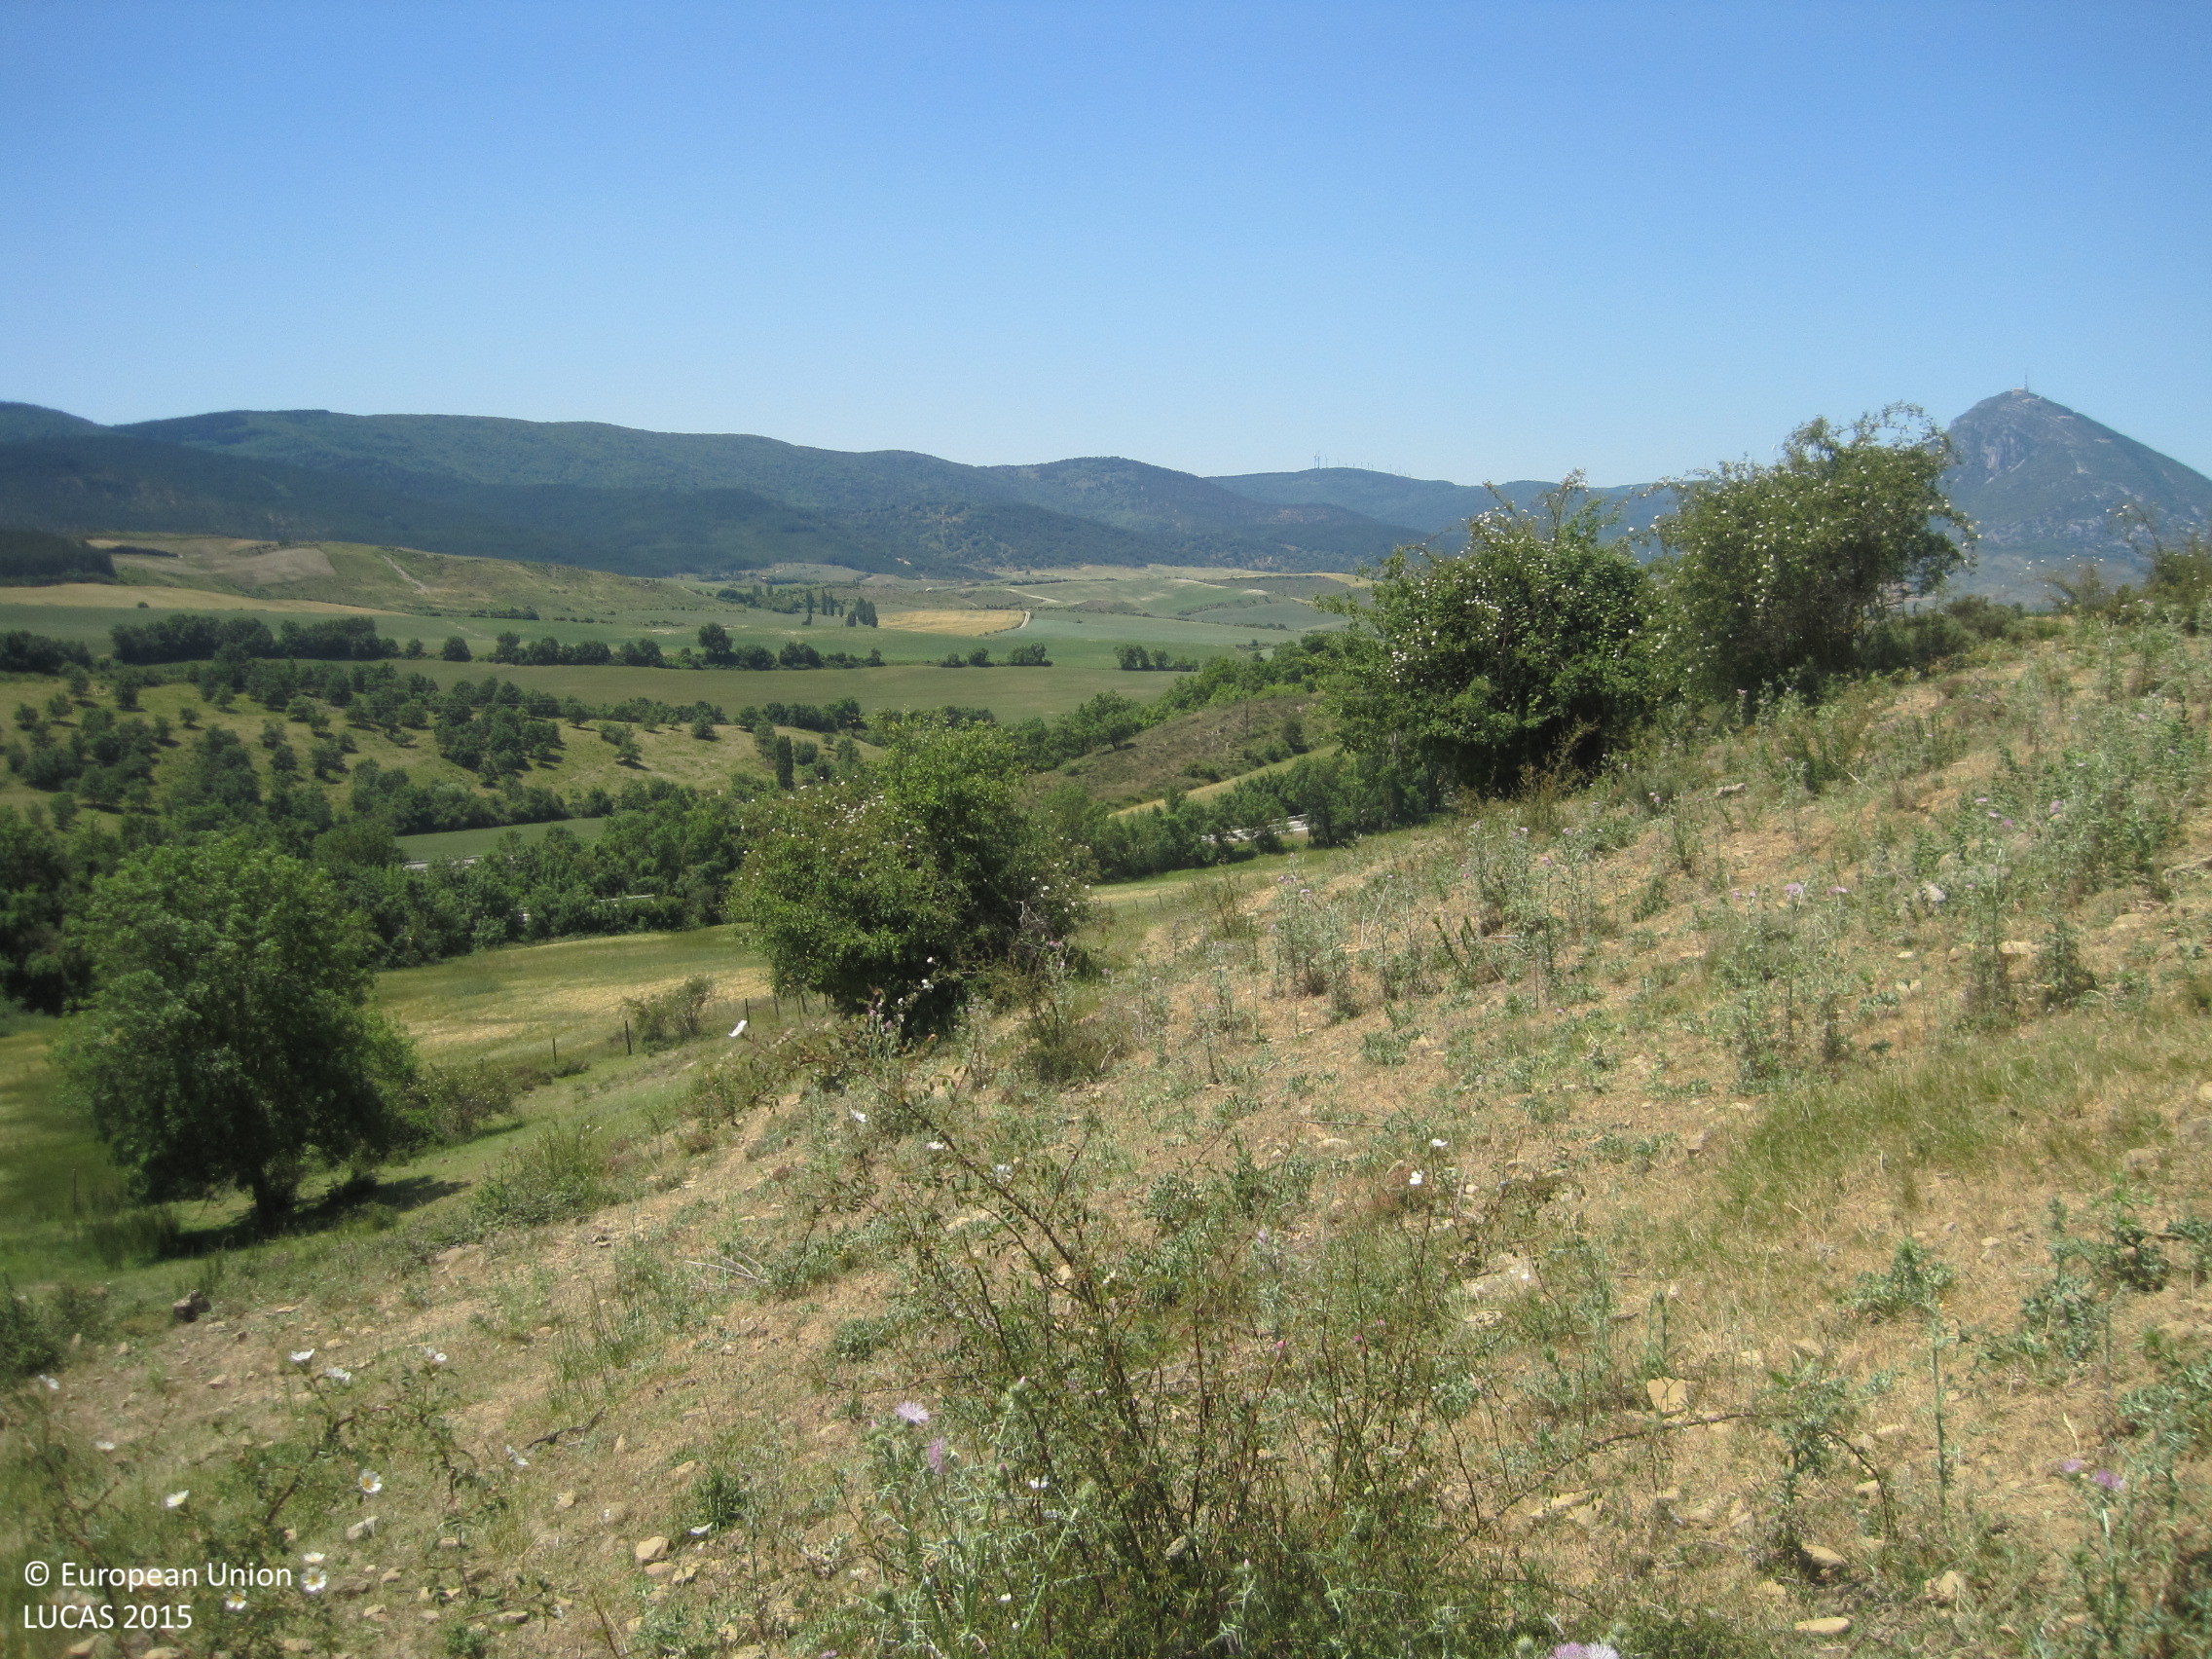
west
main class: Grassland
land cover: Grassland without tree/shrub cover
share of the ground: > 75 %
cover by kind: herbaceous plants 50 %, unconsolidated bare surface 45 %, shrubs 5 %
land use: Agriculture (excluding fallow land and kitchen gardens)
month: June
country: ES
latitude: 42.6771
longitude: -1.4457
